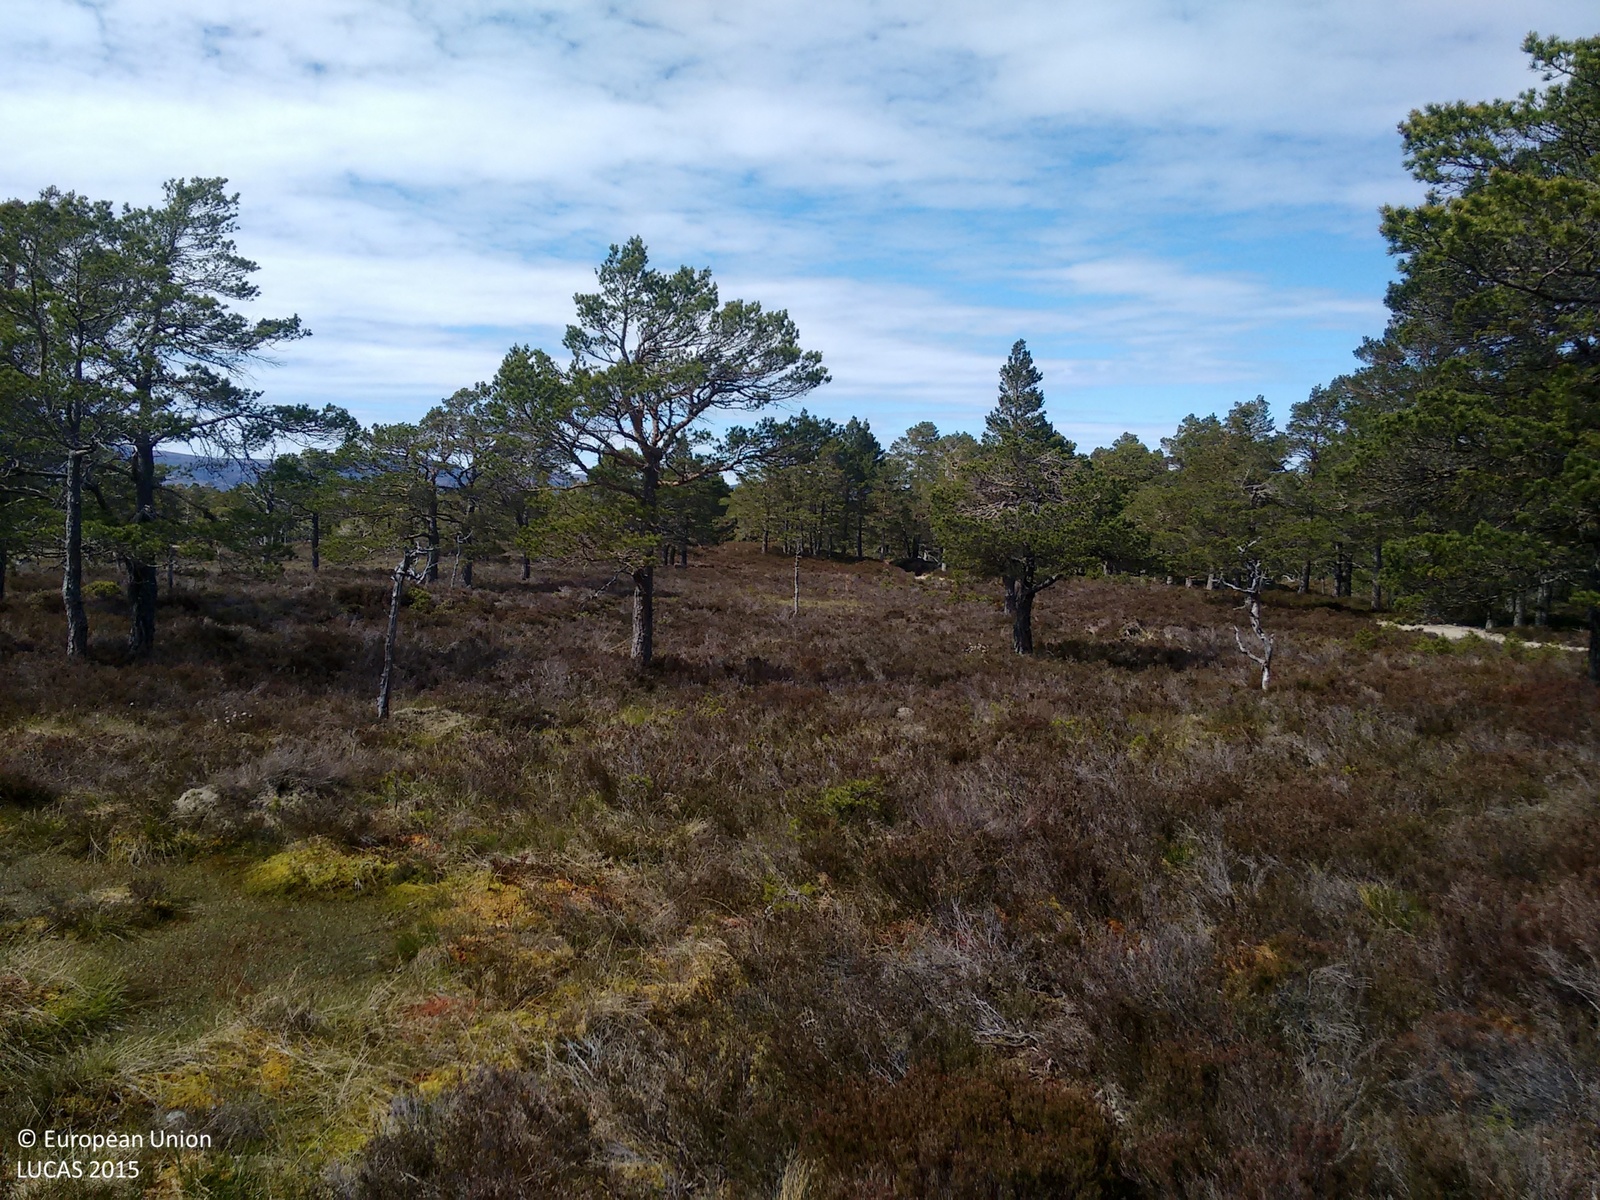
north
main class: Shrubland
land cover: Shrubland without tree cover
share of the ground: > 75 %
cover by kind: shrubs 100 %
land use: Forestry
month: June
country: GB
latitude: 57.1396
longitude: -3.7765
